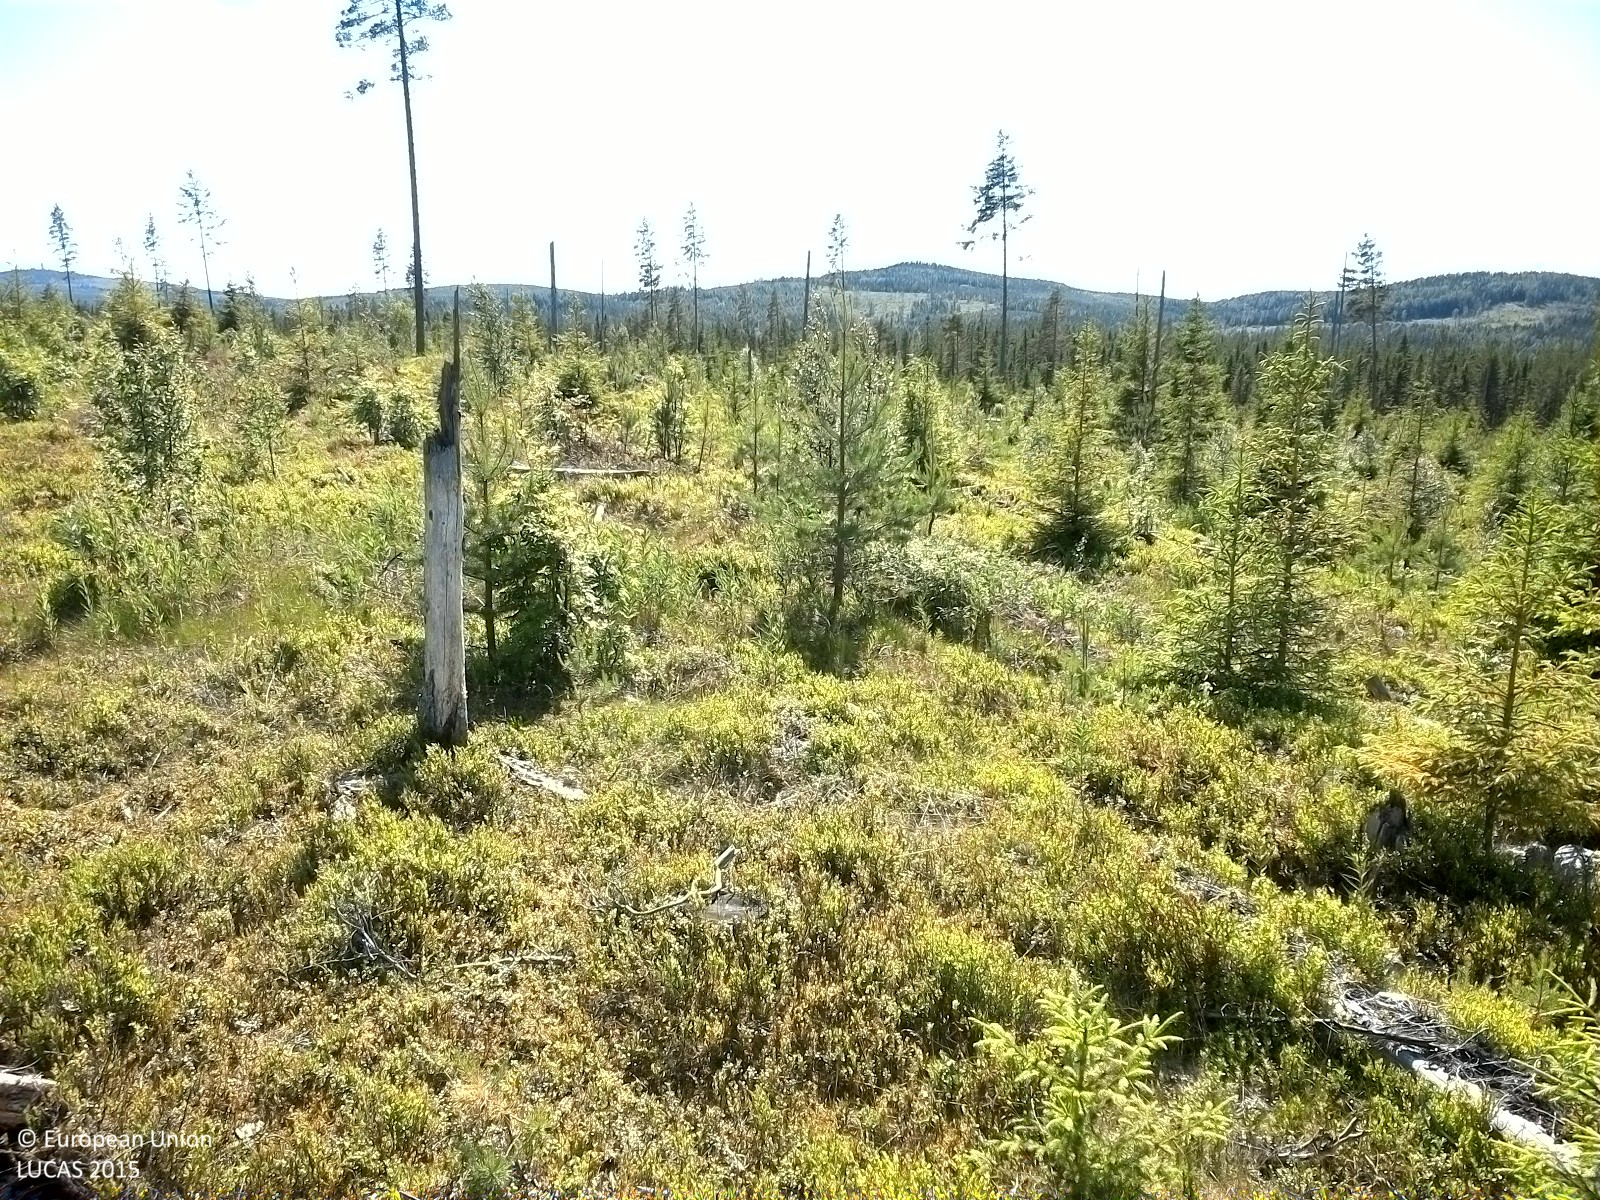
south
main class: Woodland
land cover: Spruce dominated coniferous woodland
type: boreal forest
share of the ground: 10 - 25 %
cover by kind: shrubs 70 %, coniferous forest trees 10 %, herbaceous plants 10 %, unconsolidated bare surface 10 %
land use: Forestry
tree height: < 5 m
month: July
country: SE
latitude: 62.2374
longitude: 16.8893
